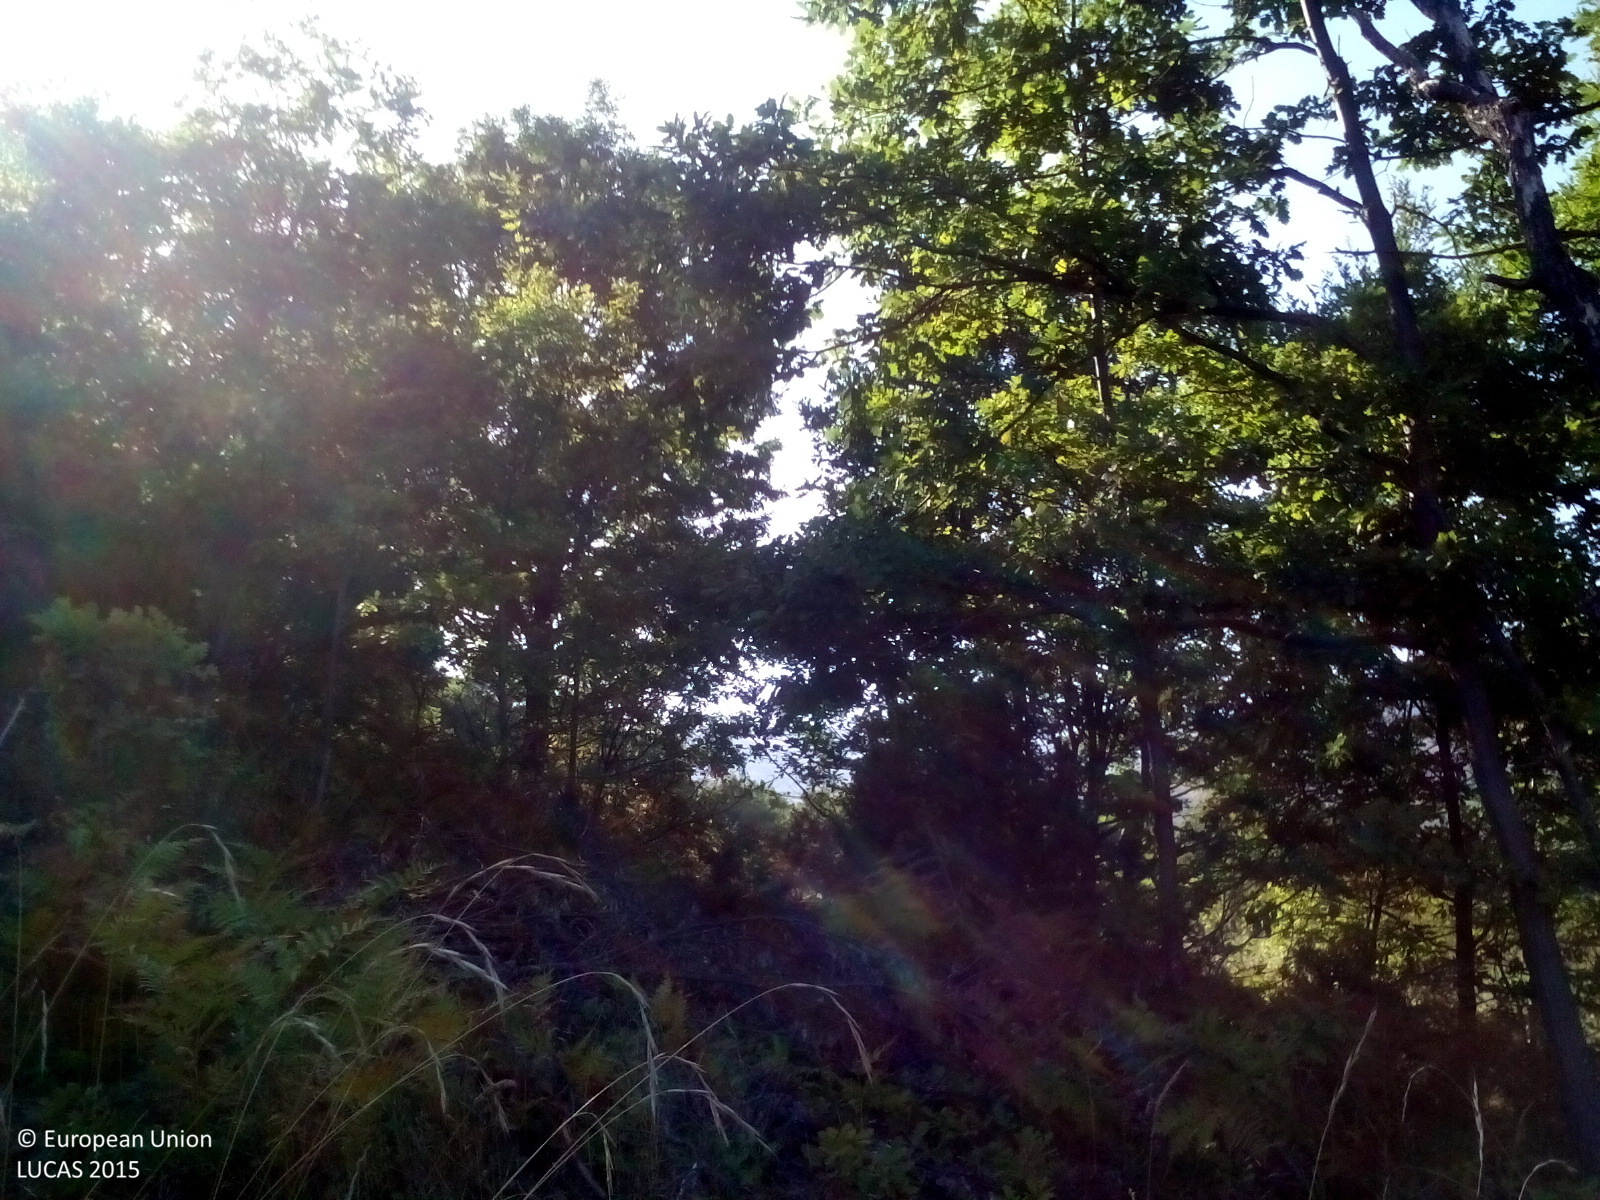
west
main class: Woodland
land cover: Broadleaved woodland
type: thermophilous deciduous forest
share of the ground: 50 - 75 %
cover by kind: broadleaved forest trees 70 %, herbaceous plants 20 %, shrubs 10 %
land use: Forestry
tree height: > 5 m
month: September
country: GR
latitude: 40.7146
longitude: 21.3925
